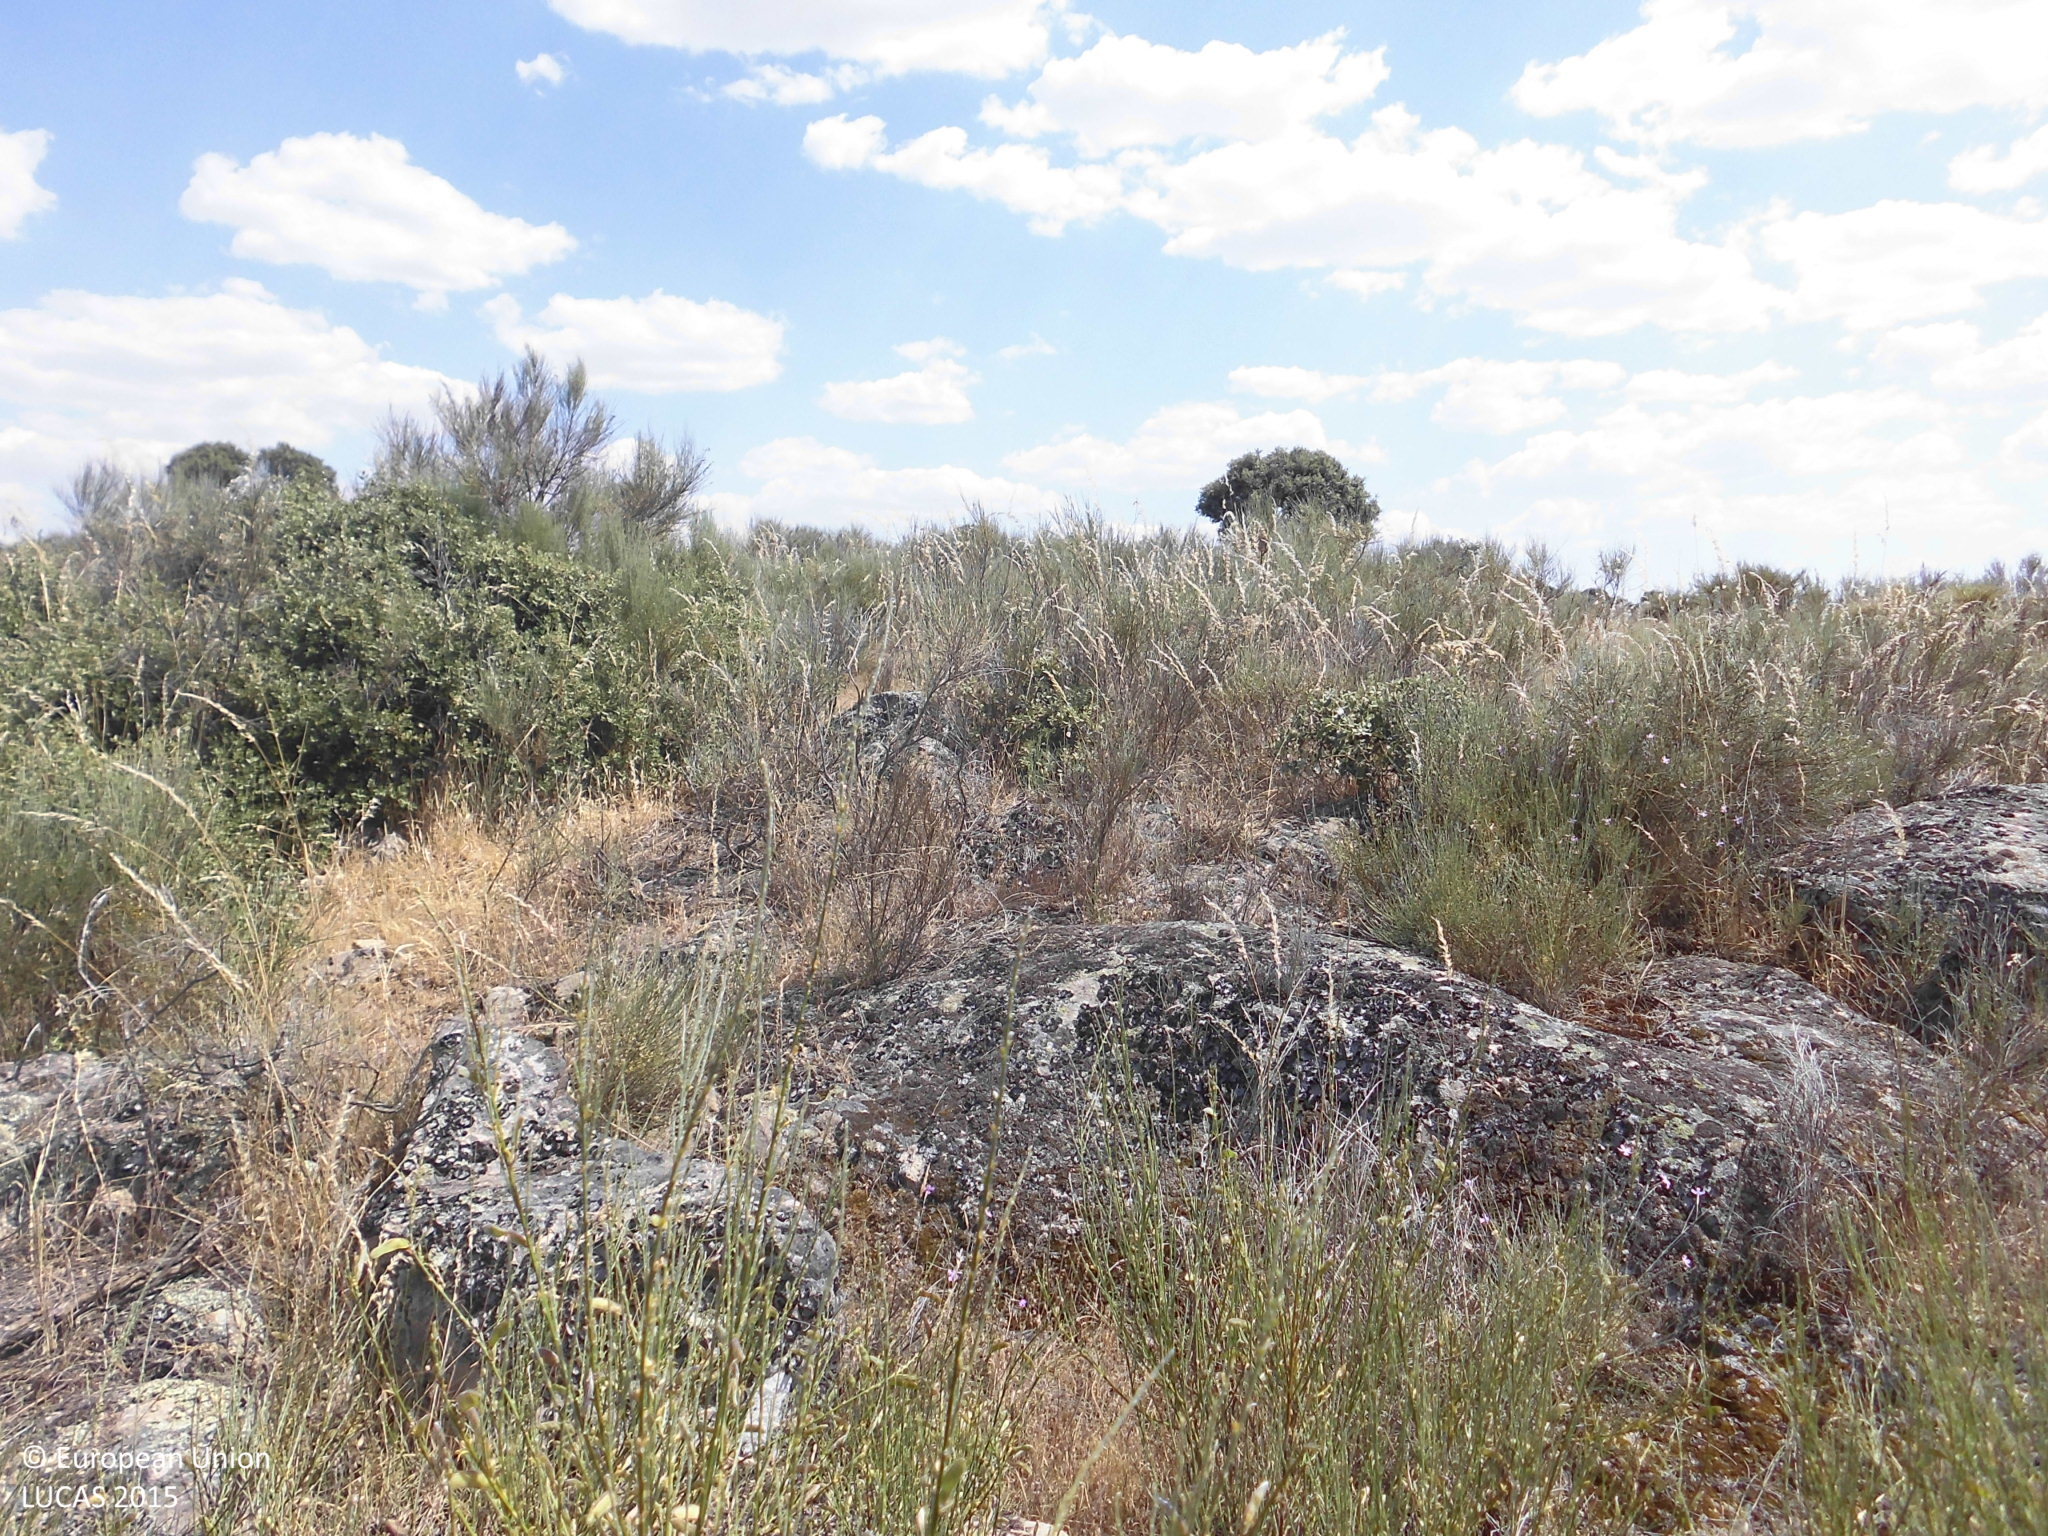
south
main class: Shrubland
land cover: Shrubland without tree cover
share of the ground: 25 - 50 %
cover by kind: herbaceous plants 50 %, shrubs 40 %
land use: Agriculture (excluding fallow land and kitchen gardens)
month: May
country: ES
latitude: 39.6289
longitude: -6.6313
